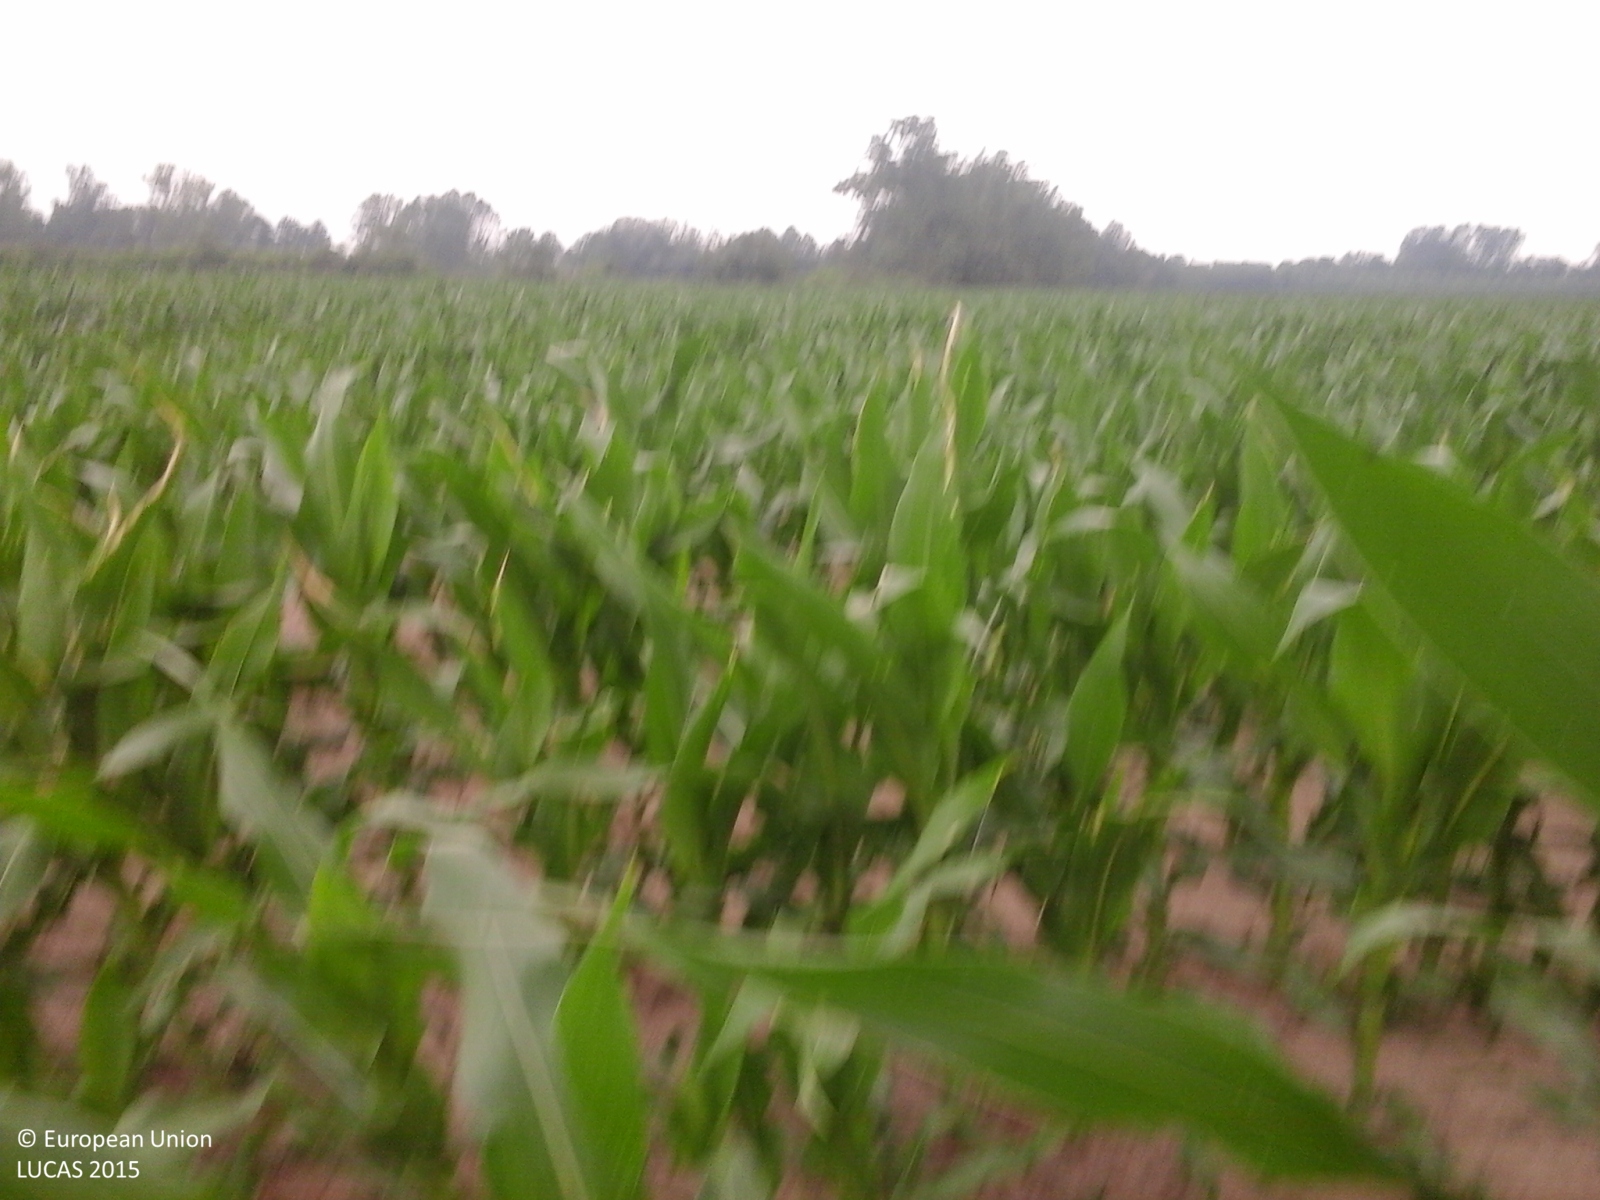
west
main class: Cropland
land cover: Maize
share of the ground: > 75 %
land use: Agriculture (excluding fallow land and kitchen gardens)
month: June
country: IT
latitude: 45.2271
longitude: 8.7922
